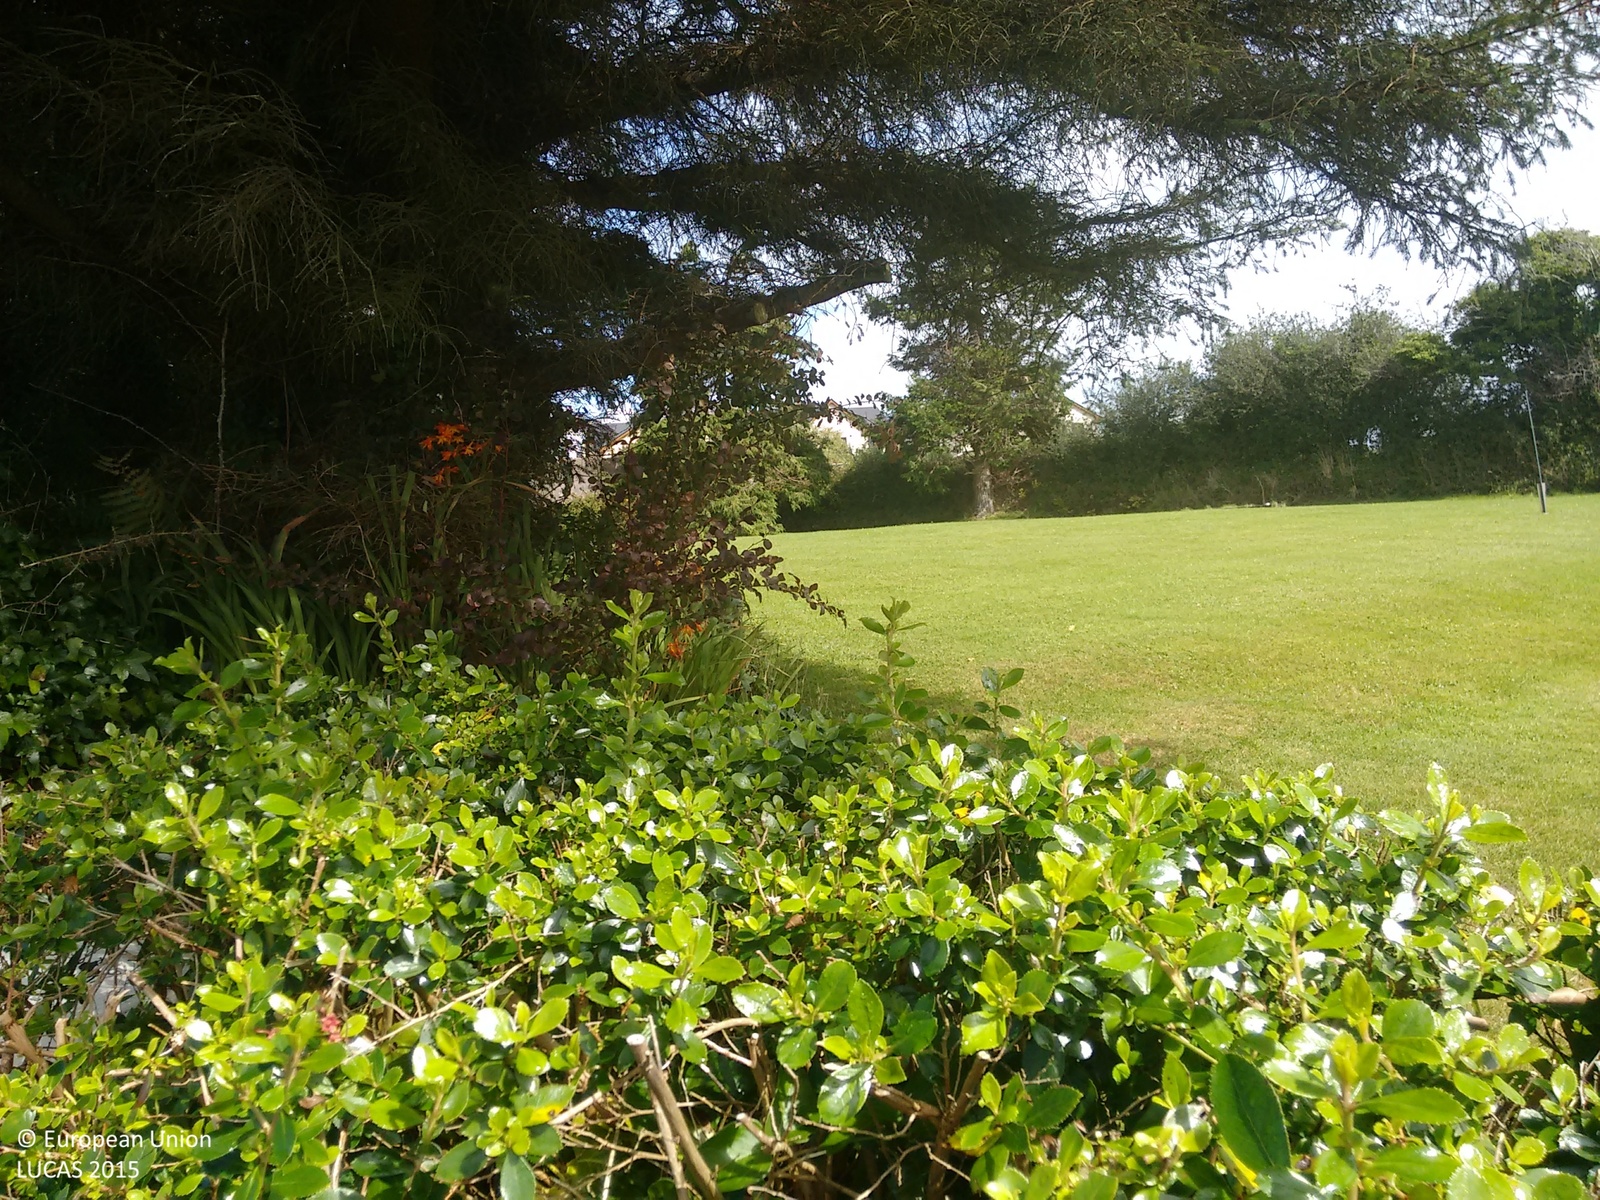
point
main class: Grassland
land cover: Grassland without tree/shrub cover
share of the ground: > 75 %
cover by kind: herbaceous plants 70 %, consolidated bare surface 25 %, shrubs 5 %
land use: Residential
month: August
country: IE
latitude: 52.0955
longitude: -9.7904
